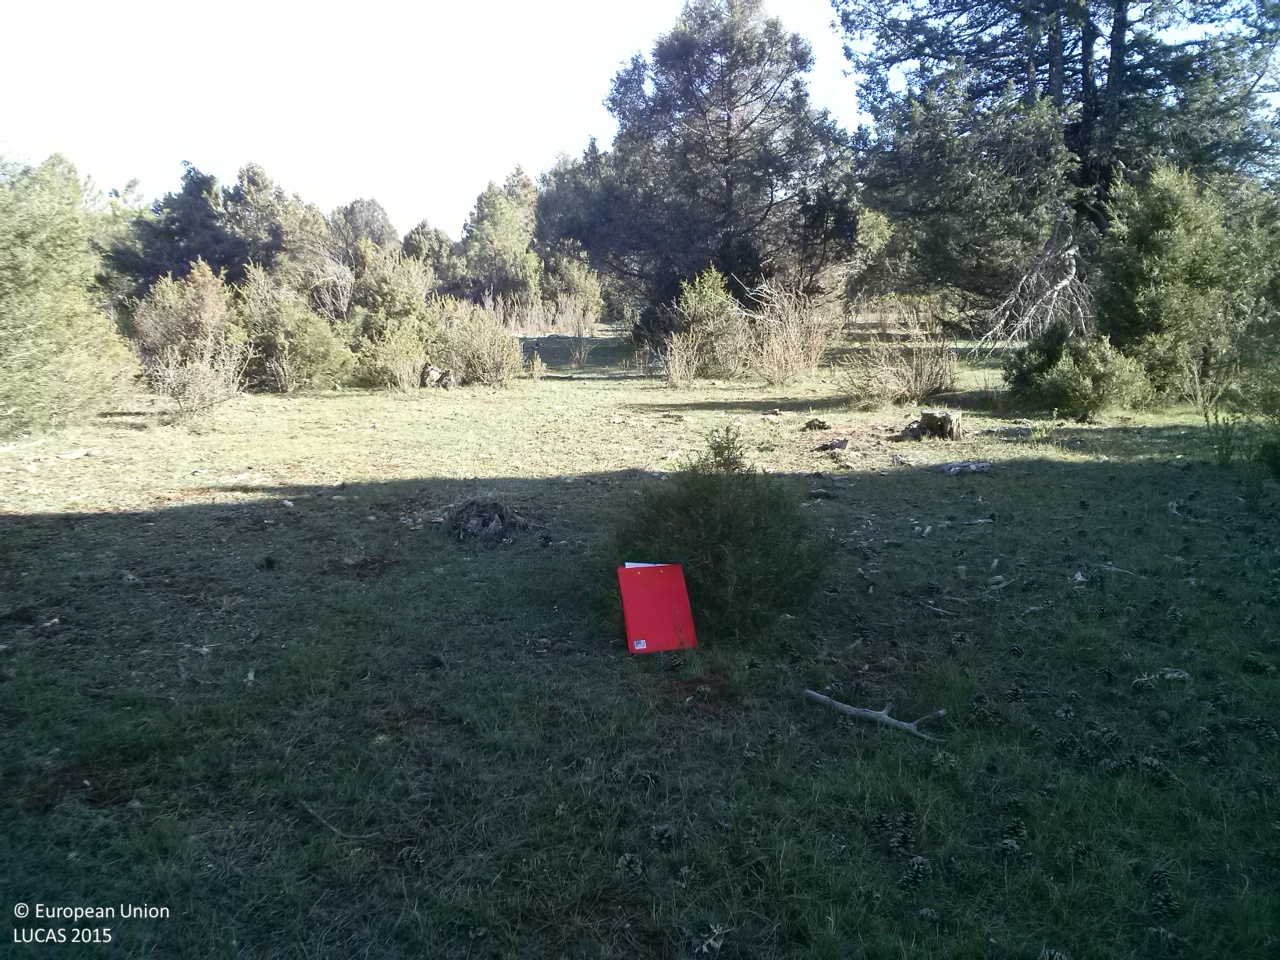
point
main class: Woodland
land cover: Other coniferous woodland
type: coniferous forest of the mediterranean region
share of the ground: 25 - 50 %
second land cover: Grassland without tree/shrub cover
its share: 50 - 75 %
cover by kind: herbaceous plants 60 %, coniferous forest trees 35 %, shrubs 5 %
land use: Forestry
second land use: Agriculture (excluding fallow land and kitchen gardens)
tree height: > 5 m
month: April
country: ES
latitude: 40.1482
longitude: -1.8586
